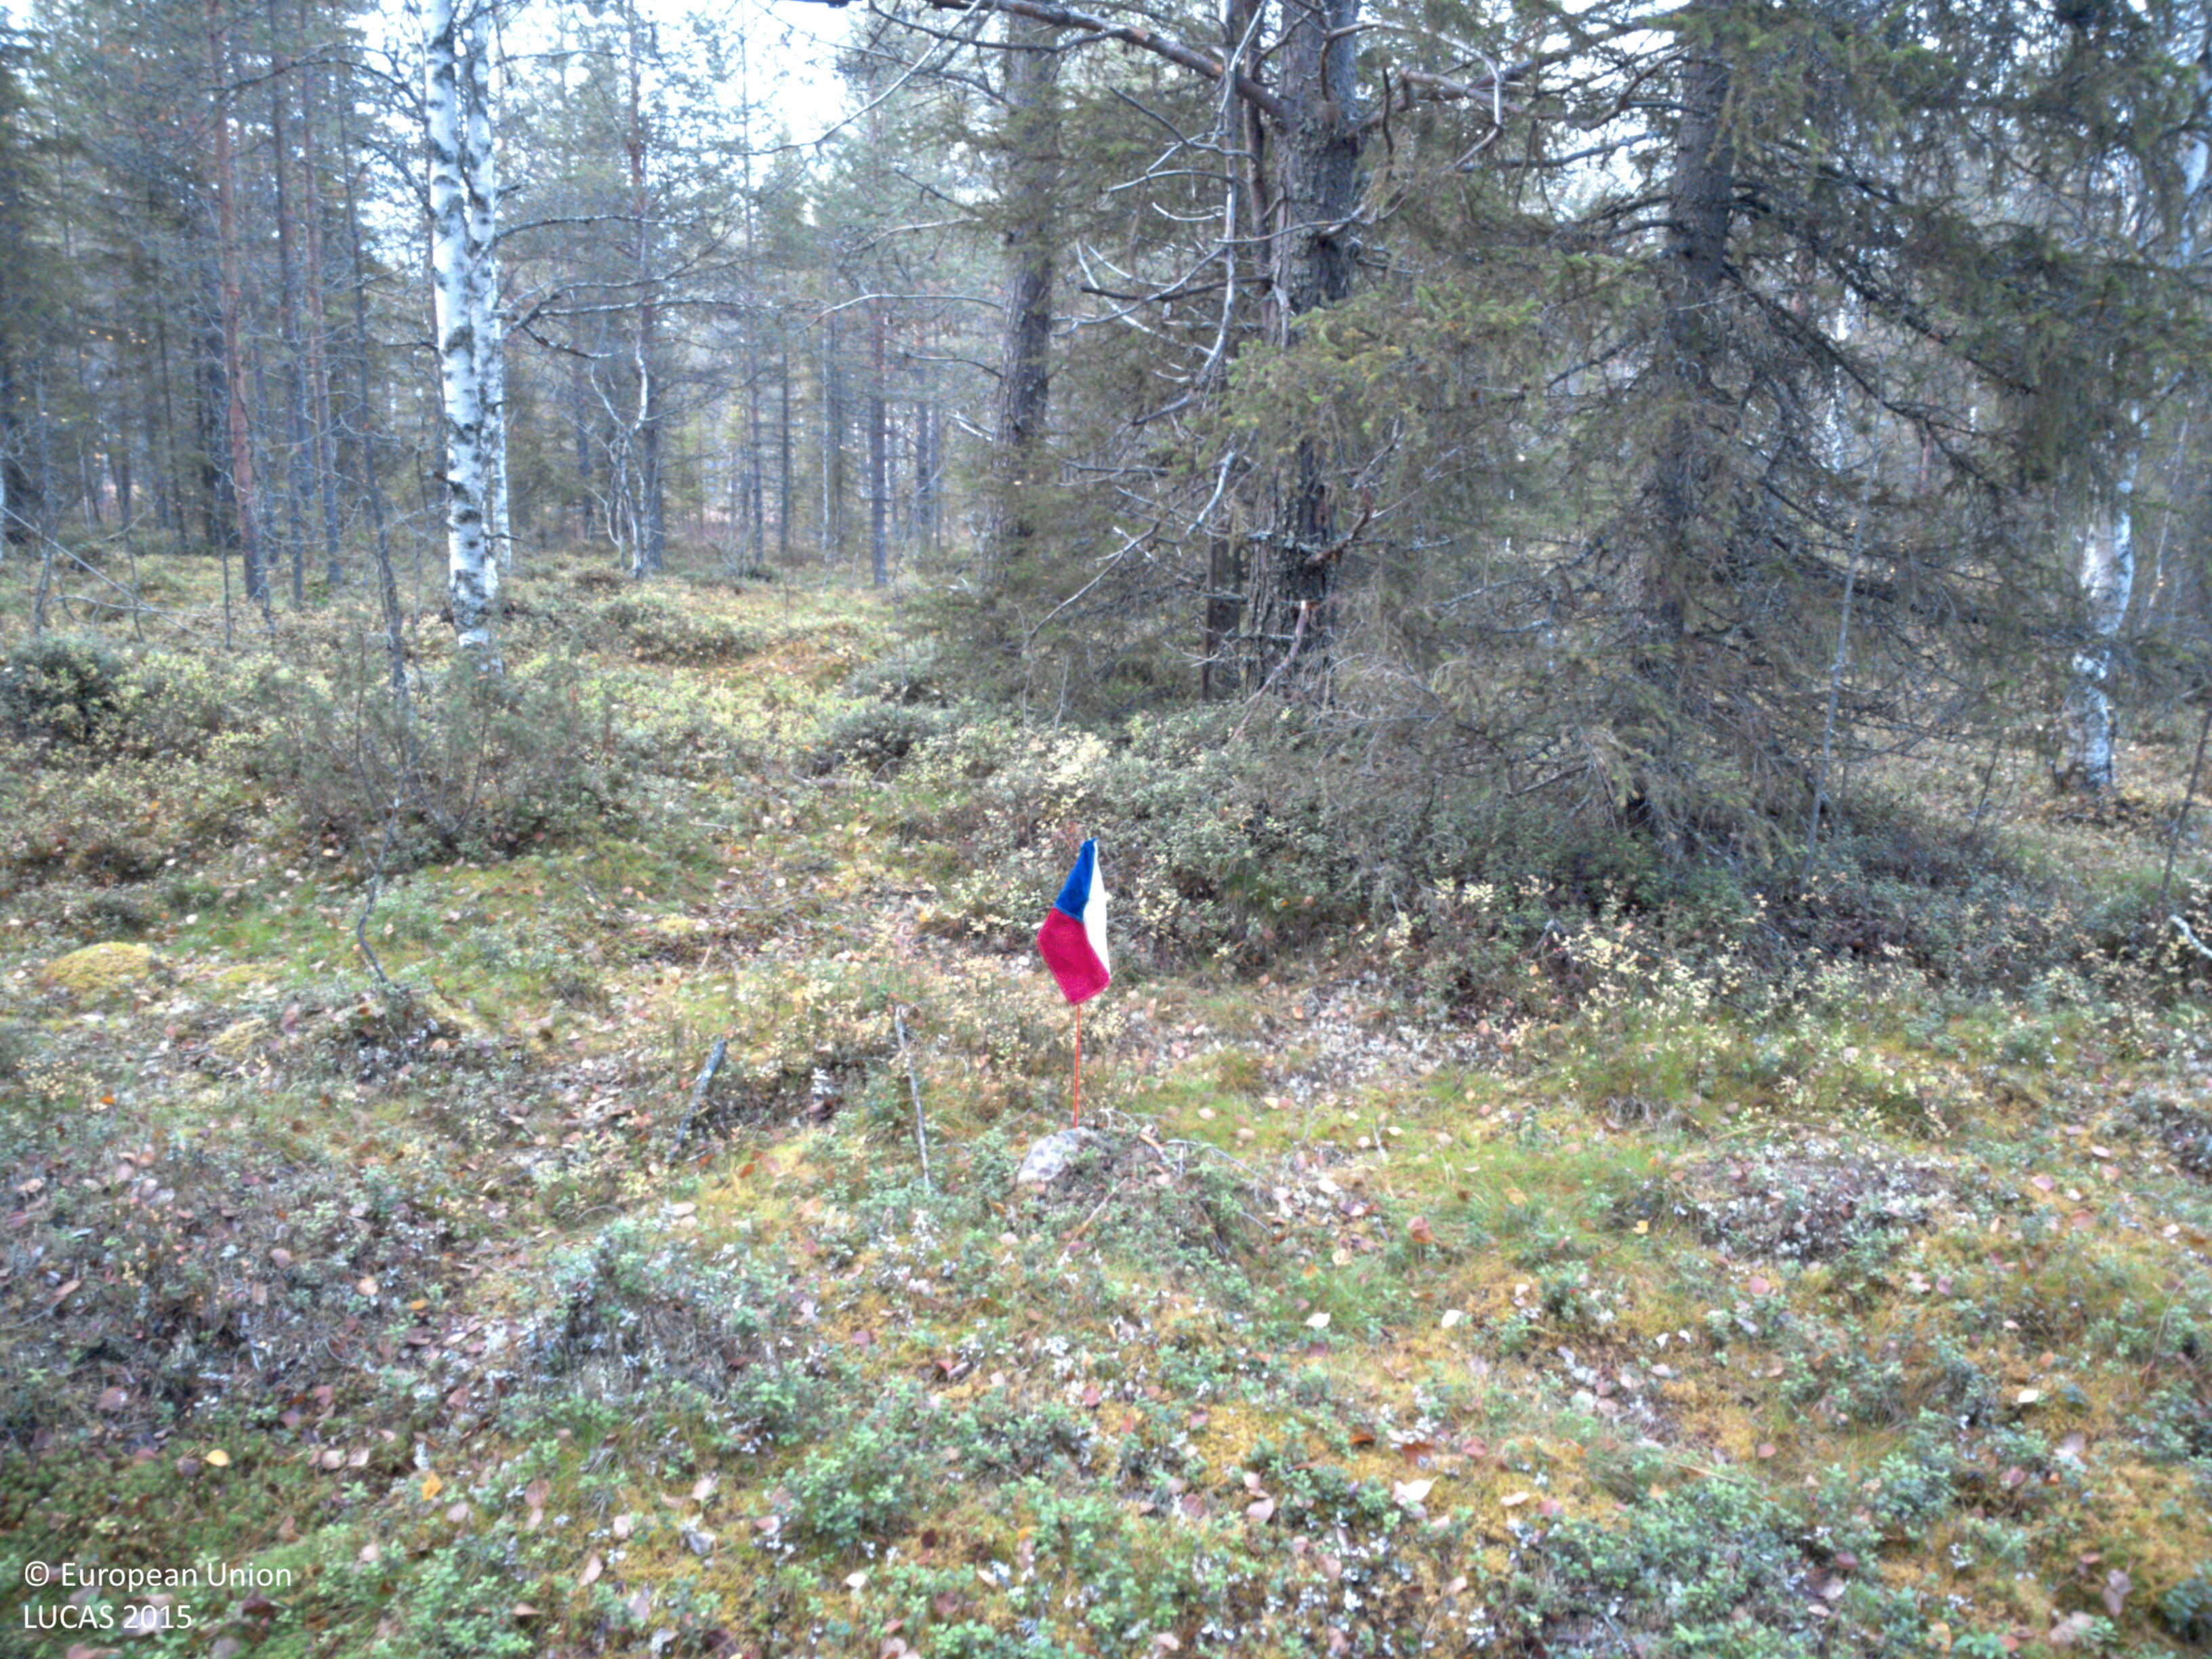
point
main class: Woodland
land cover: Pine dominated mixed woodland
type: boreal forest
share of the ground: > 75 %
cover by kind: coniferous forest trees 60 %, broadleaved forest trees 20 %, shrubs 15 %, lichens and mosses 5 %
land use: Forestry
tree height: > 5 m
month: September
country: SE
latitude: 65.0373
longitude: 18.6073
